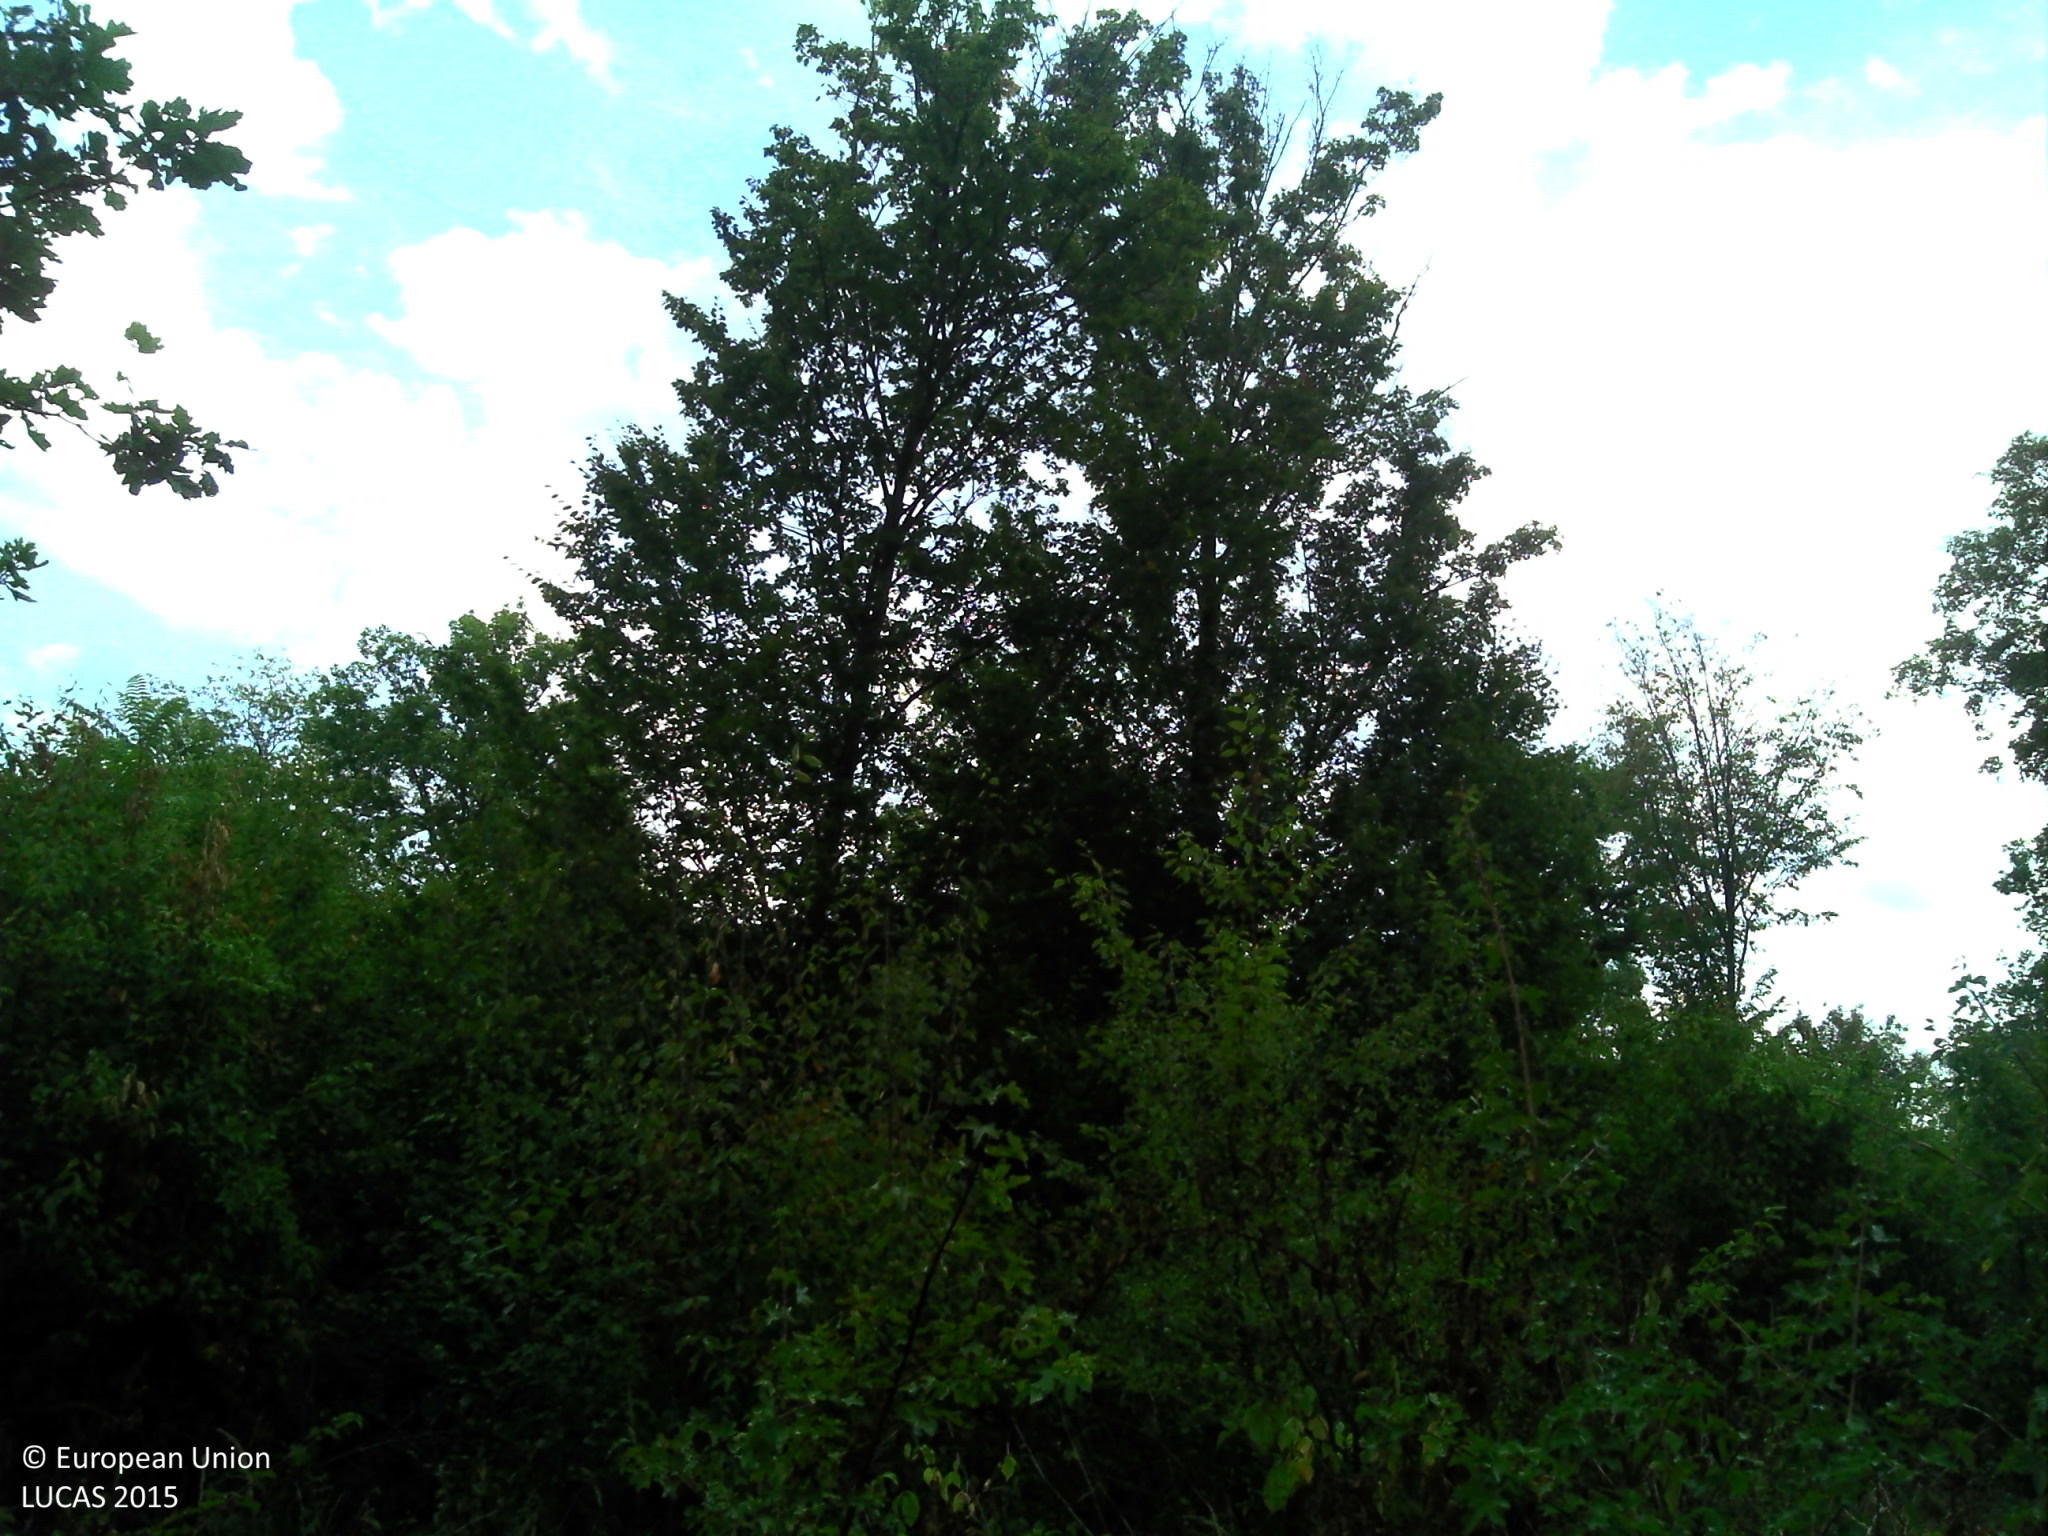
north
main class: Woodland
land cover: Broadleaved woodland
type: mesophytic deciduous forest
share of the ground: > 75 %
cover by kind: broadleaved forest trees 85 %, herbaceous plants 15 %
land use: Semi-natural and natural areas not in use
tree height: > 5 m
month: August
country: FR
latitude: 48.0504
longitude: 7.4656
